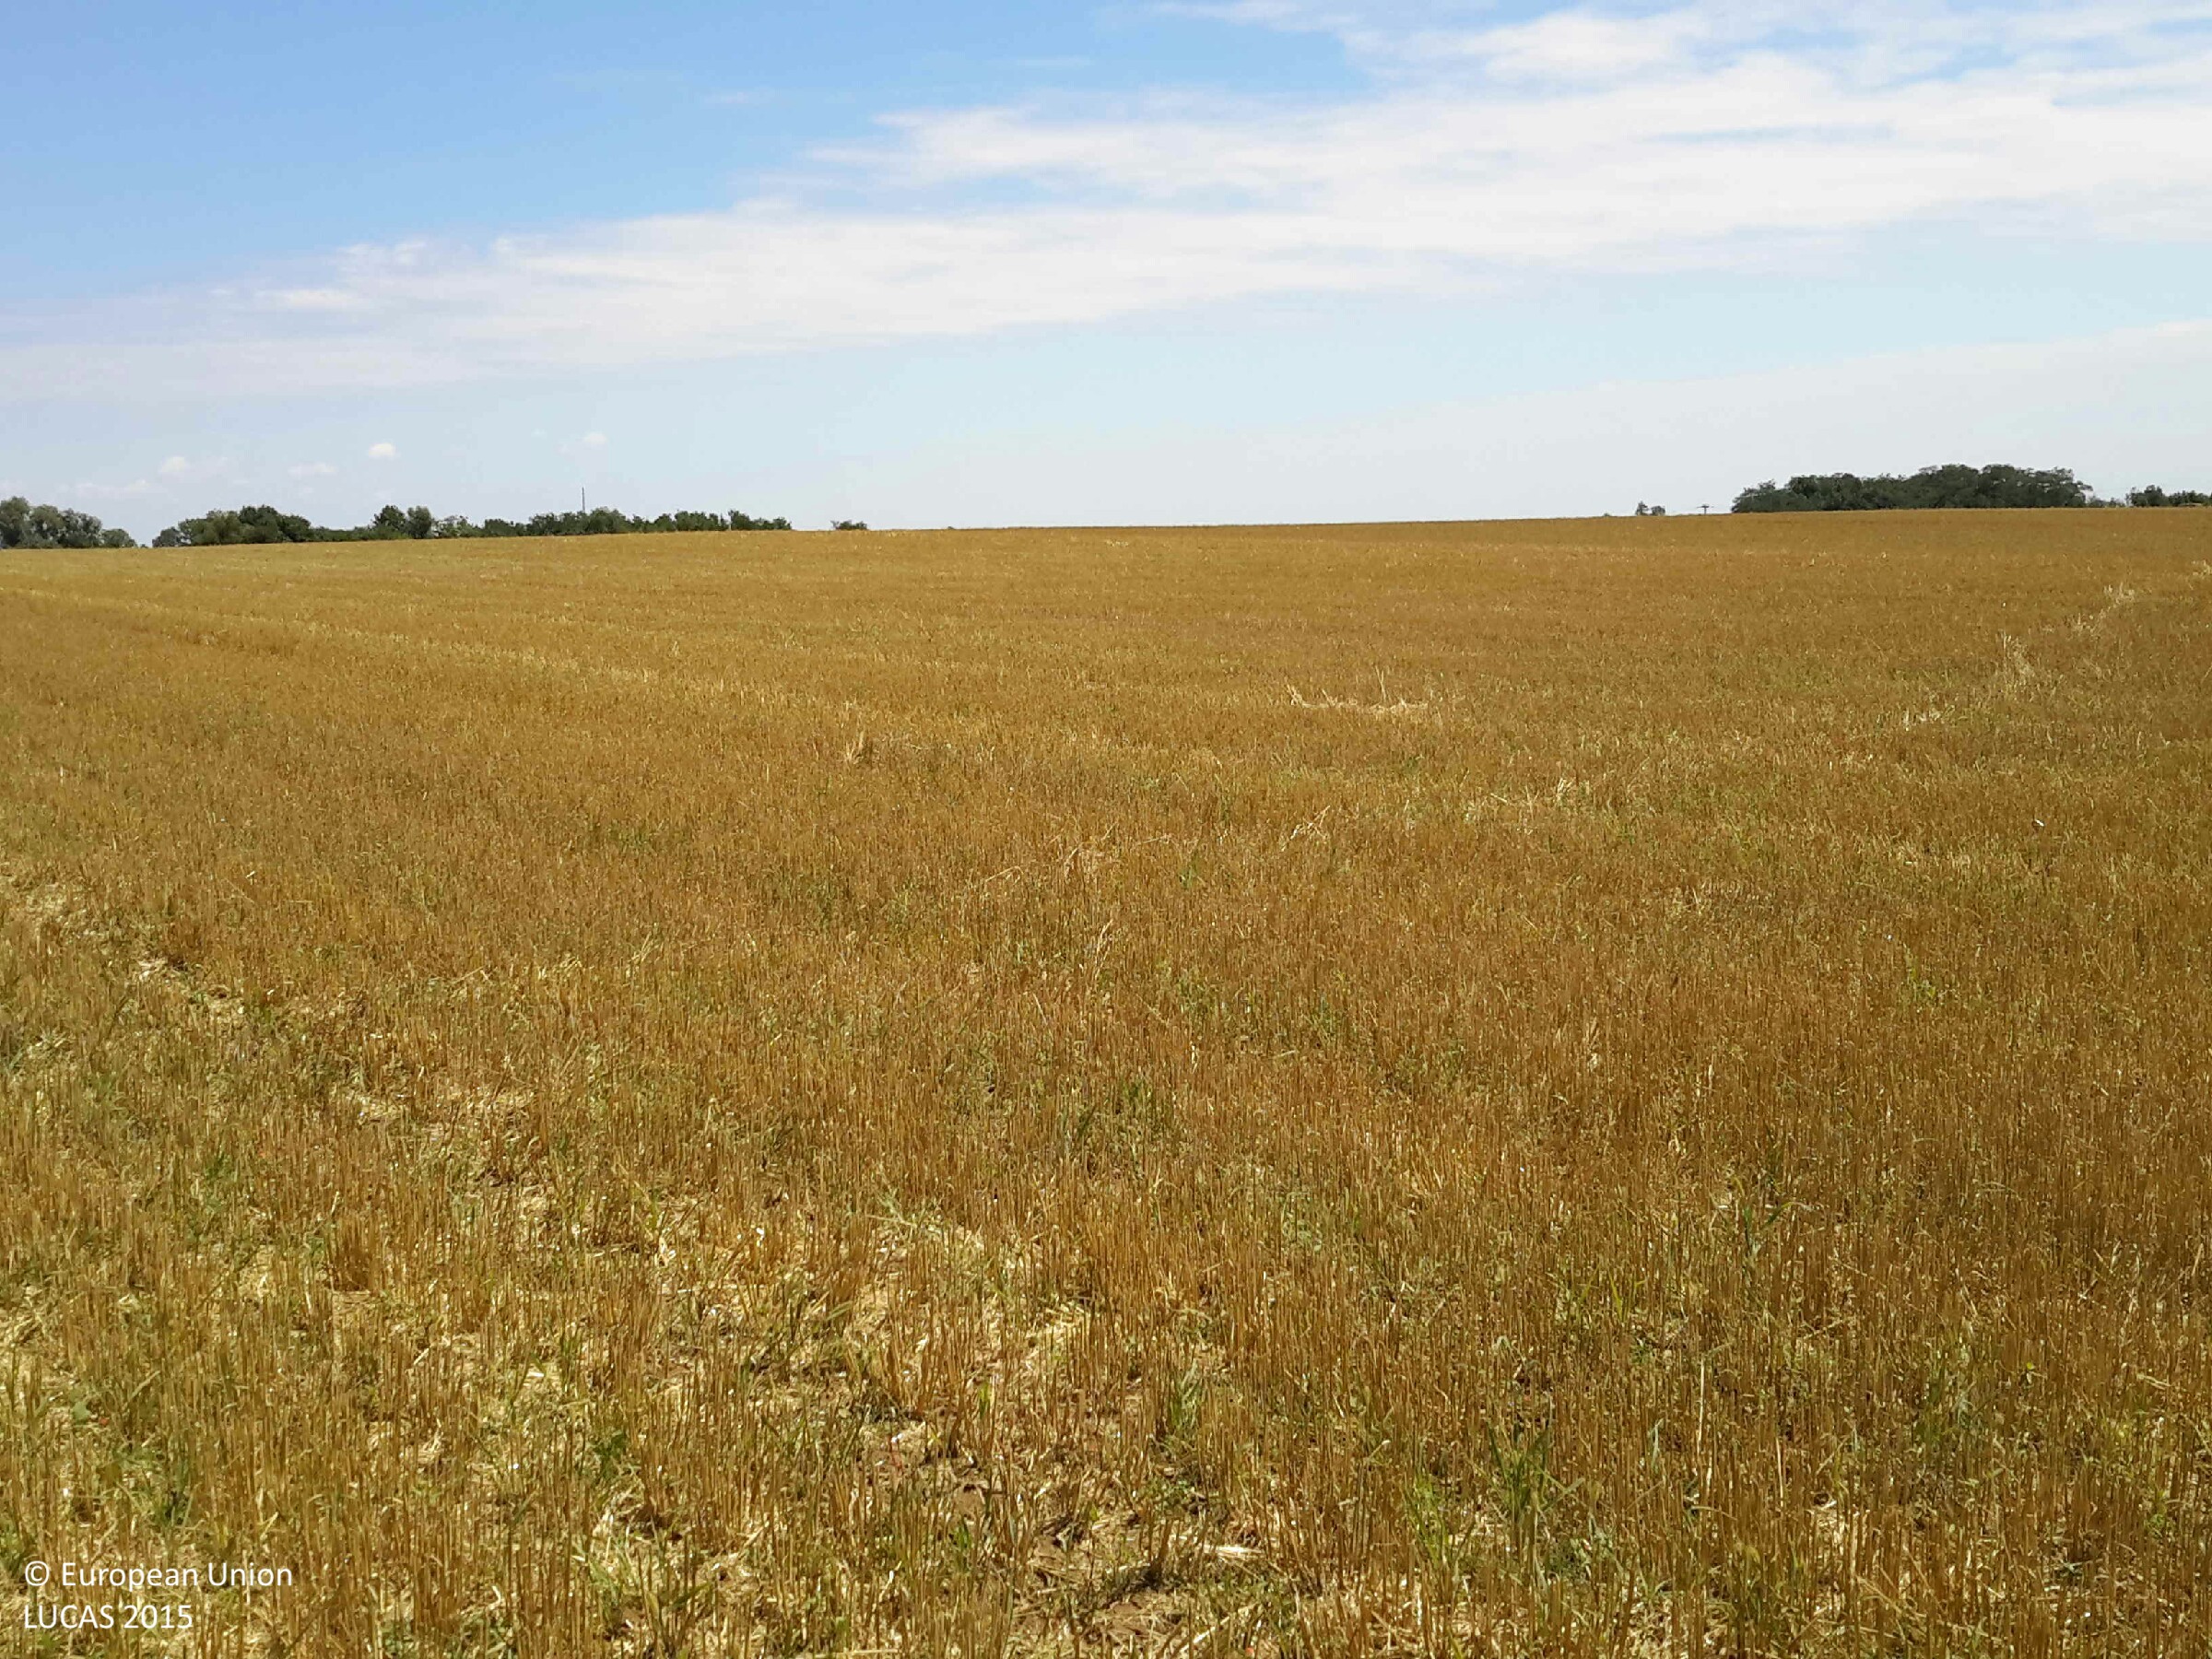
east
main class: Cropland
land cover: Common wheat
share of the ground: > 75 %
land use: Agriculture (excluding fallow land and kitchen gardens)
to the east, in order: Common wheat
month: July
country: HU
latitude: 47.1957
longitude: 16.5898
